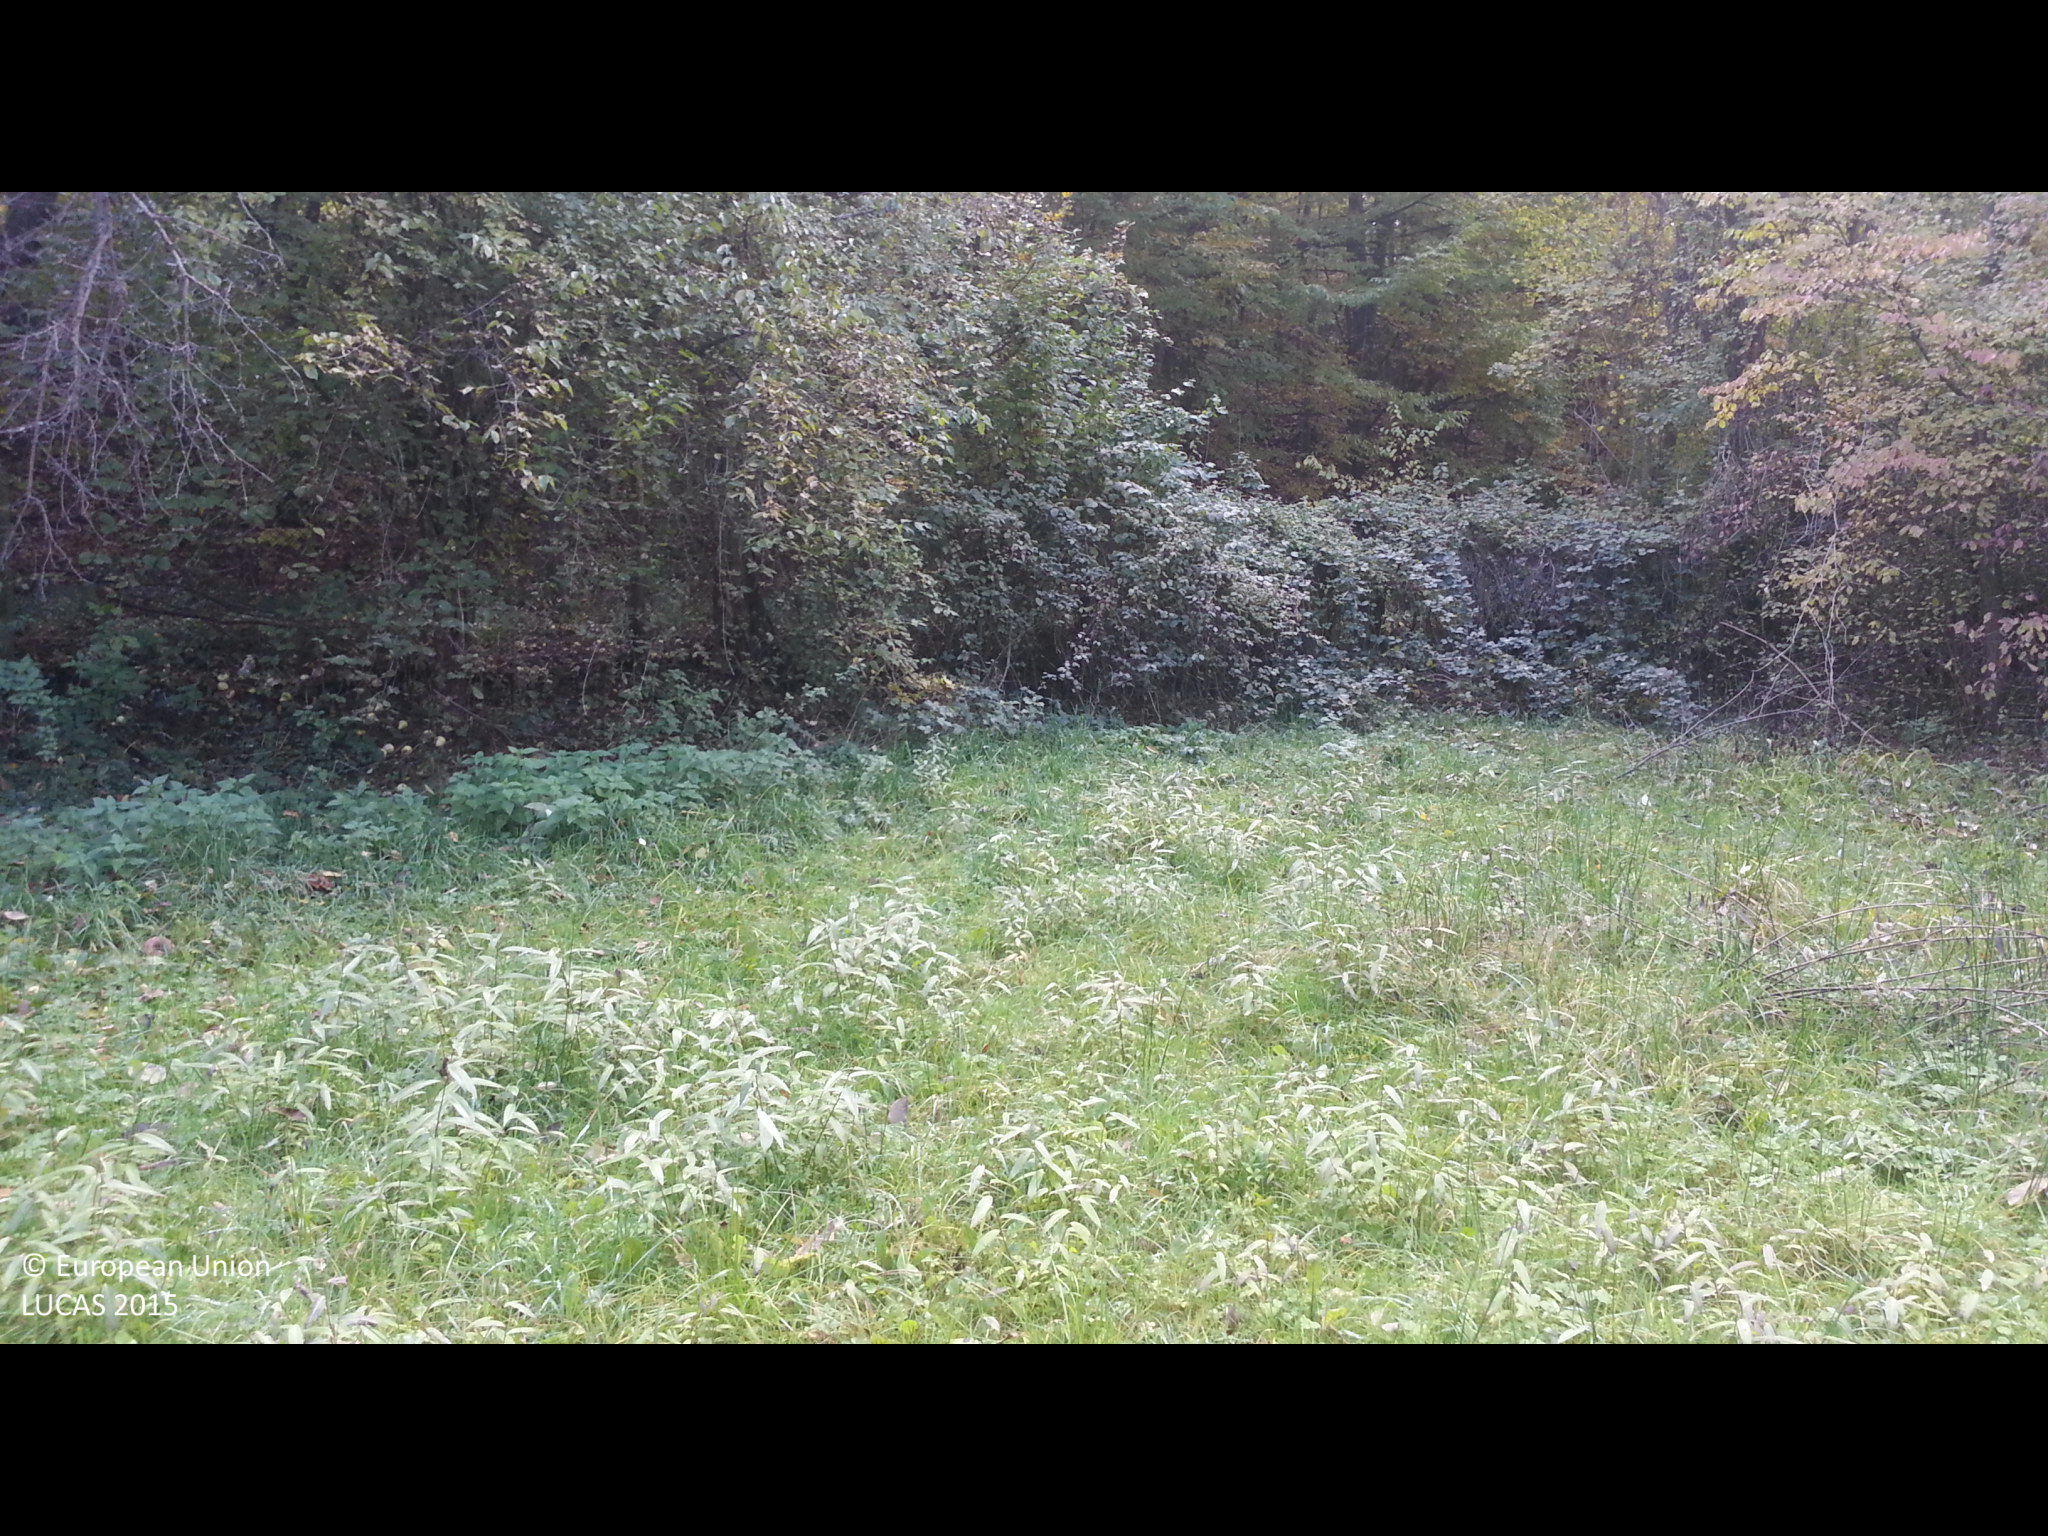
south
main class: Grassland
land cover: Grassland without tree/shrub cover
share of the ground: > 75 %
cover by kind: herbaceous plants 100 %
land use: Agriculture (excluding fallow land and kitchen gardens)
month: November
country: BG
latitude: 42.8983
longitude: 23.8959
